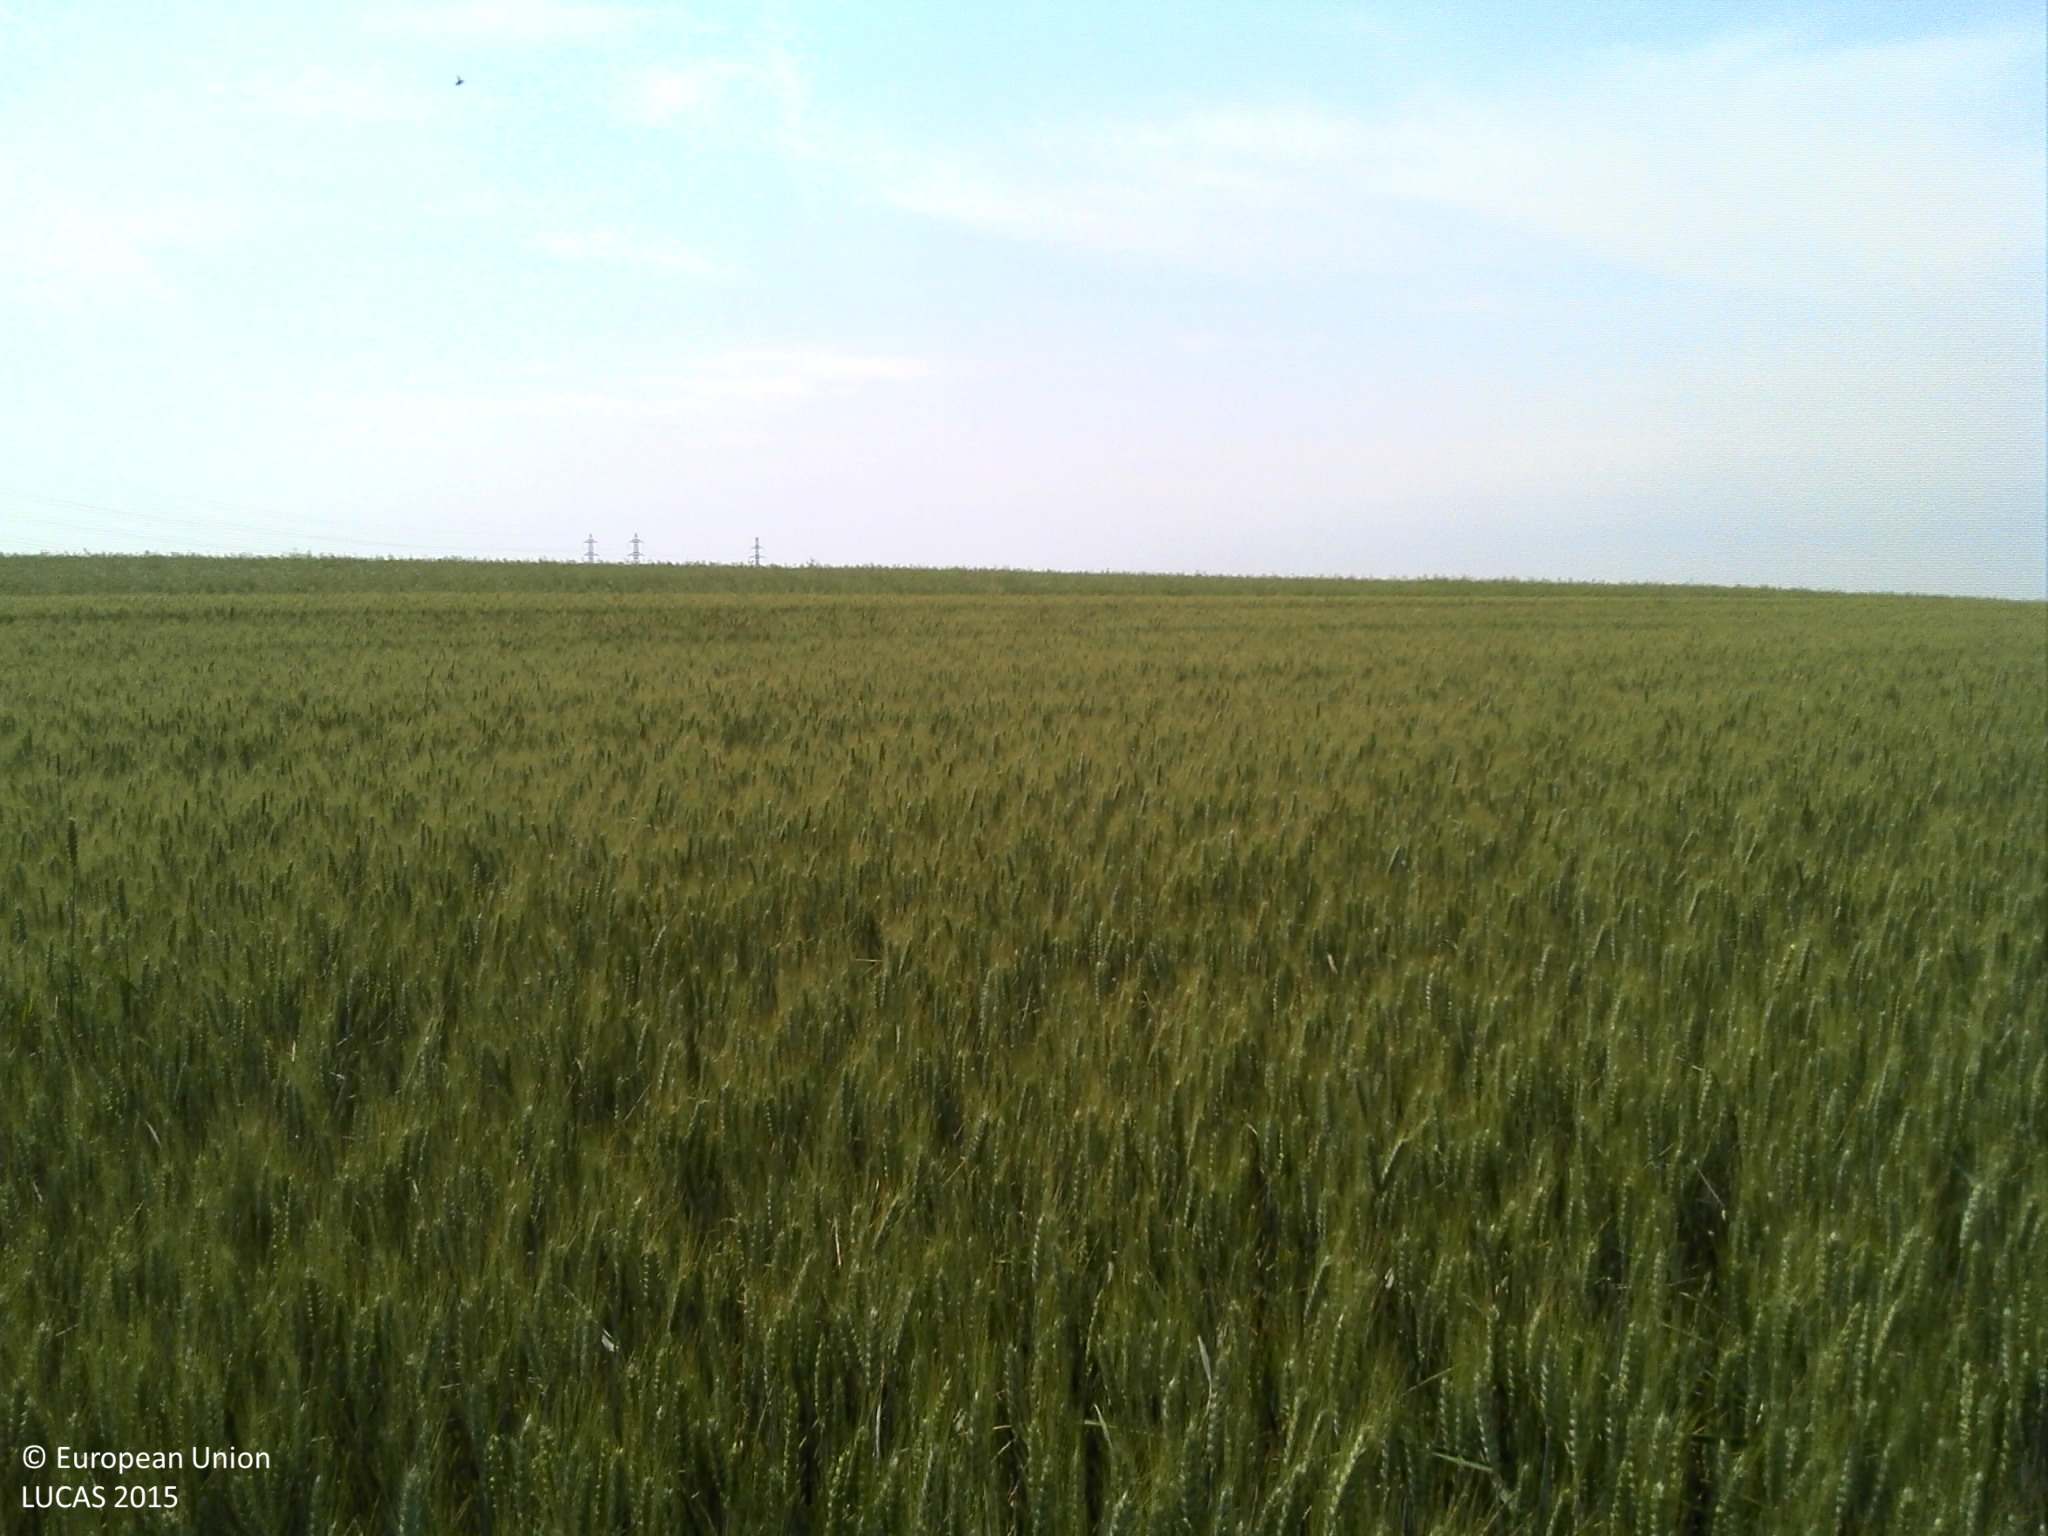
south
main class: Cropland
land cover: Common wheat
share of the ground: > 75 %
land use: Agriculture (excluding fallow land and kitchen gardens)
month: June
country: FR
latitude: 49.1856
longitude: 6.2267
